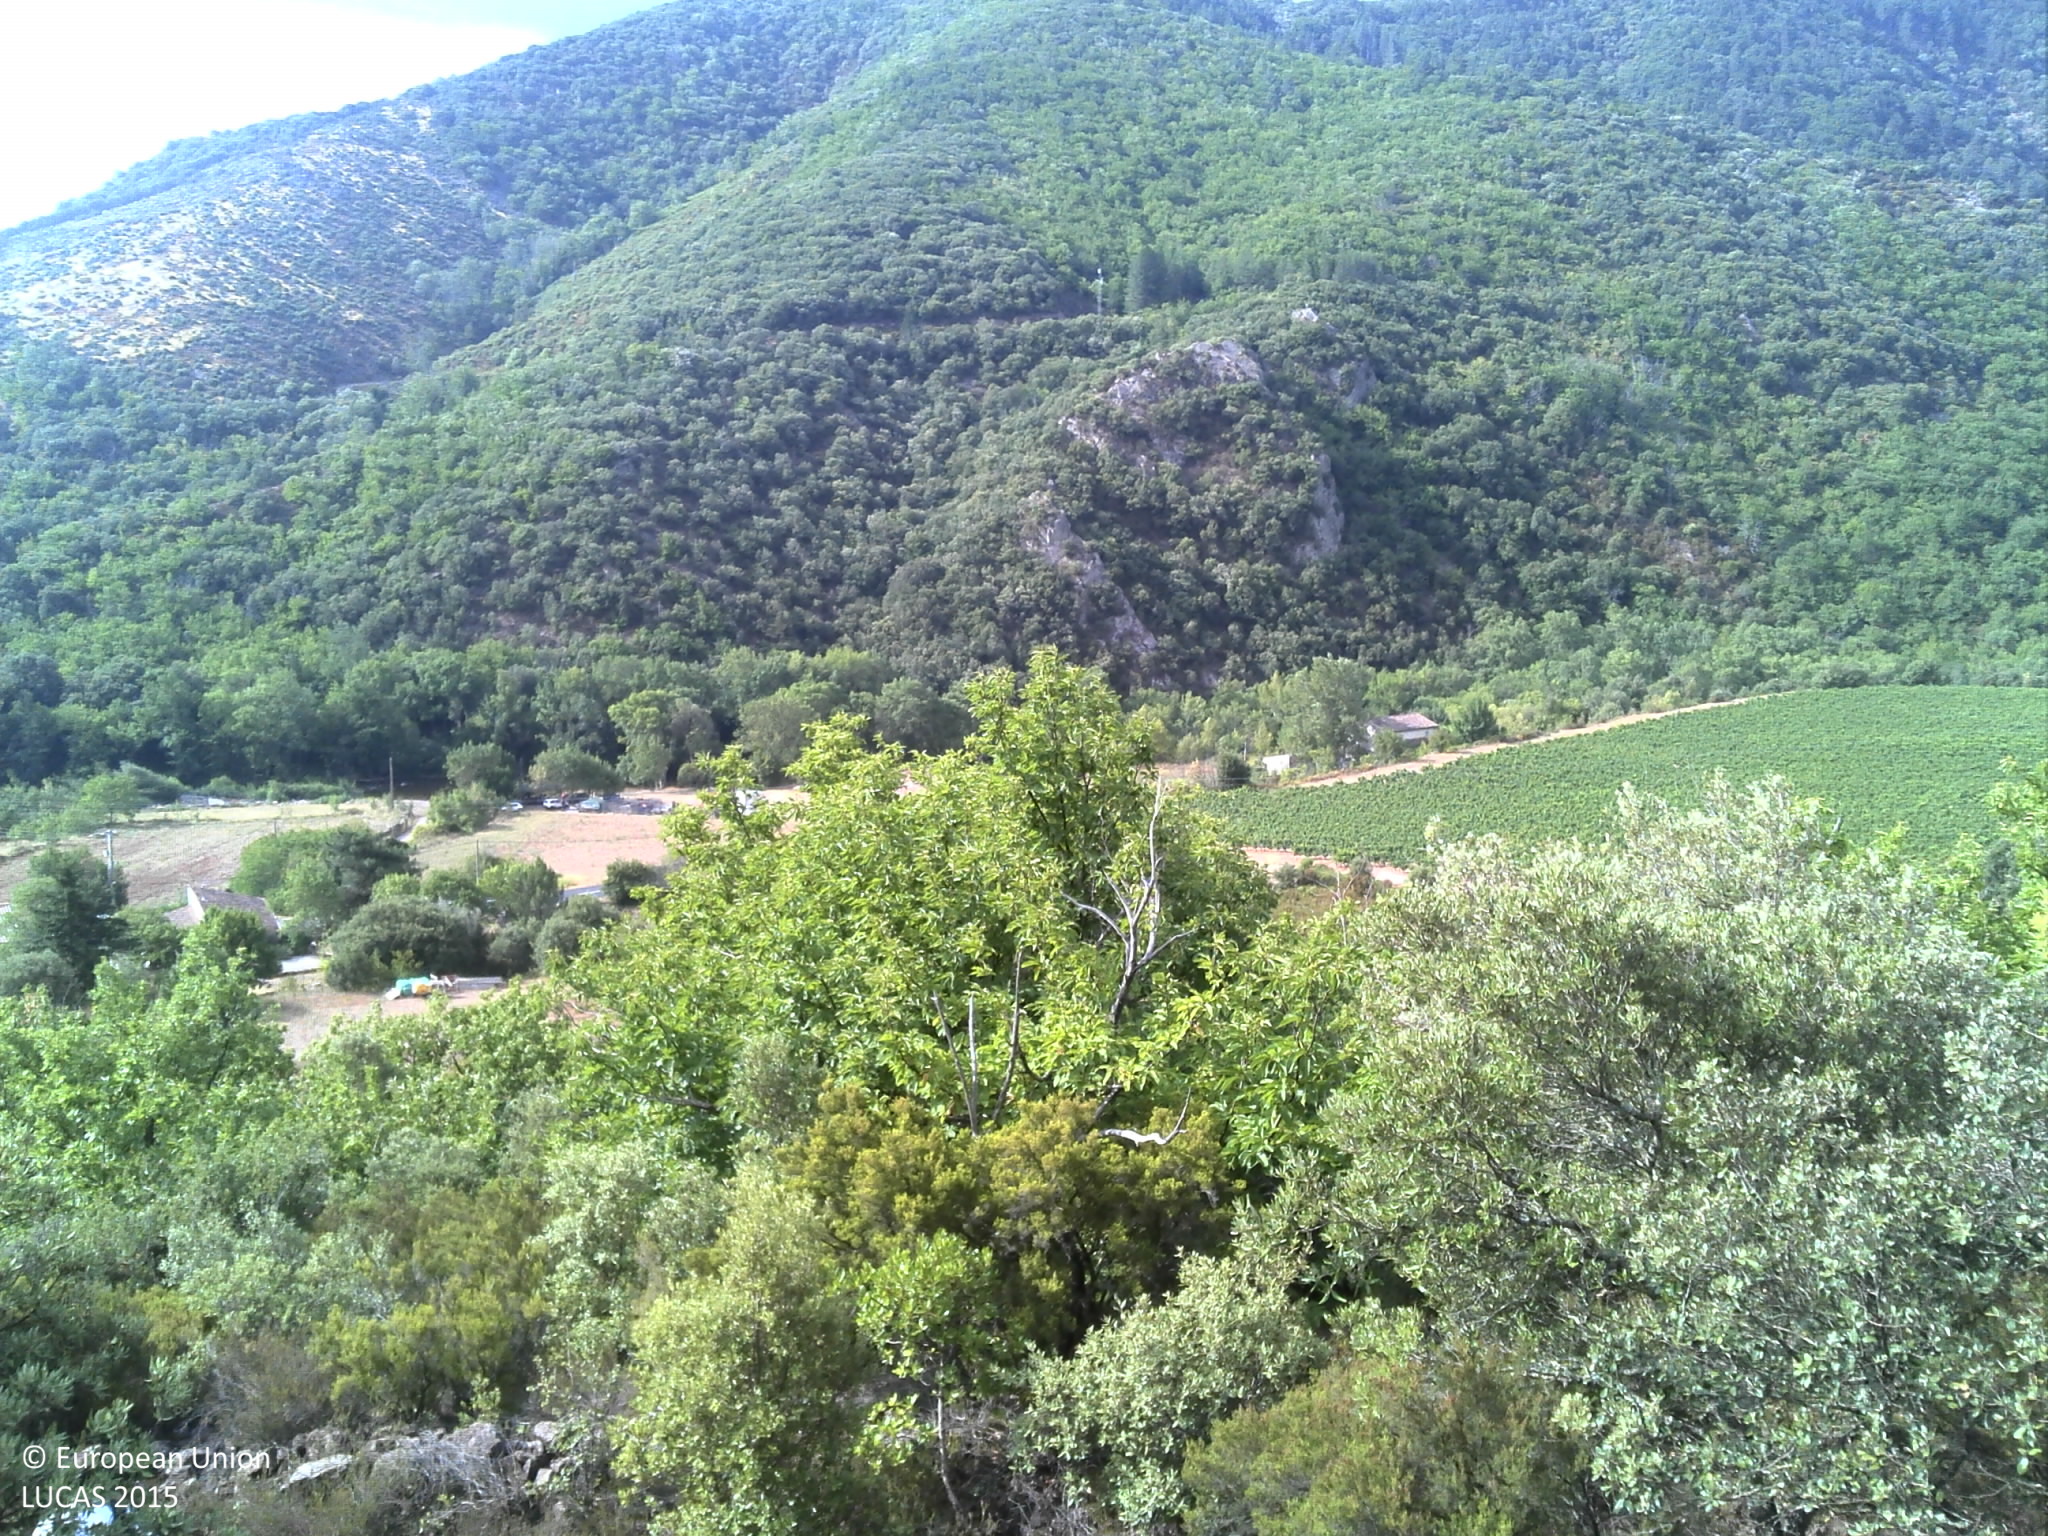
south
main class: Shrubland
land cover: Shrubland with sparse tree cover
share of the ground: > 75 %
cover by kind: shrubs 70 %, consolidated bare surface 25 %, broadleaved forest trees 5 %
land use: Semi-natural and natural areas not in use
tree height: < 5 m
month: July
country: FR
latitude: 43.7254
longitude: 3.1428
